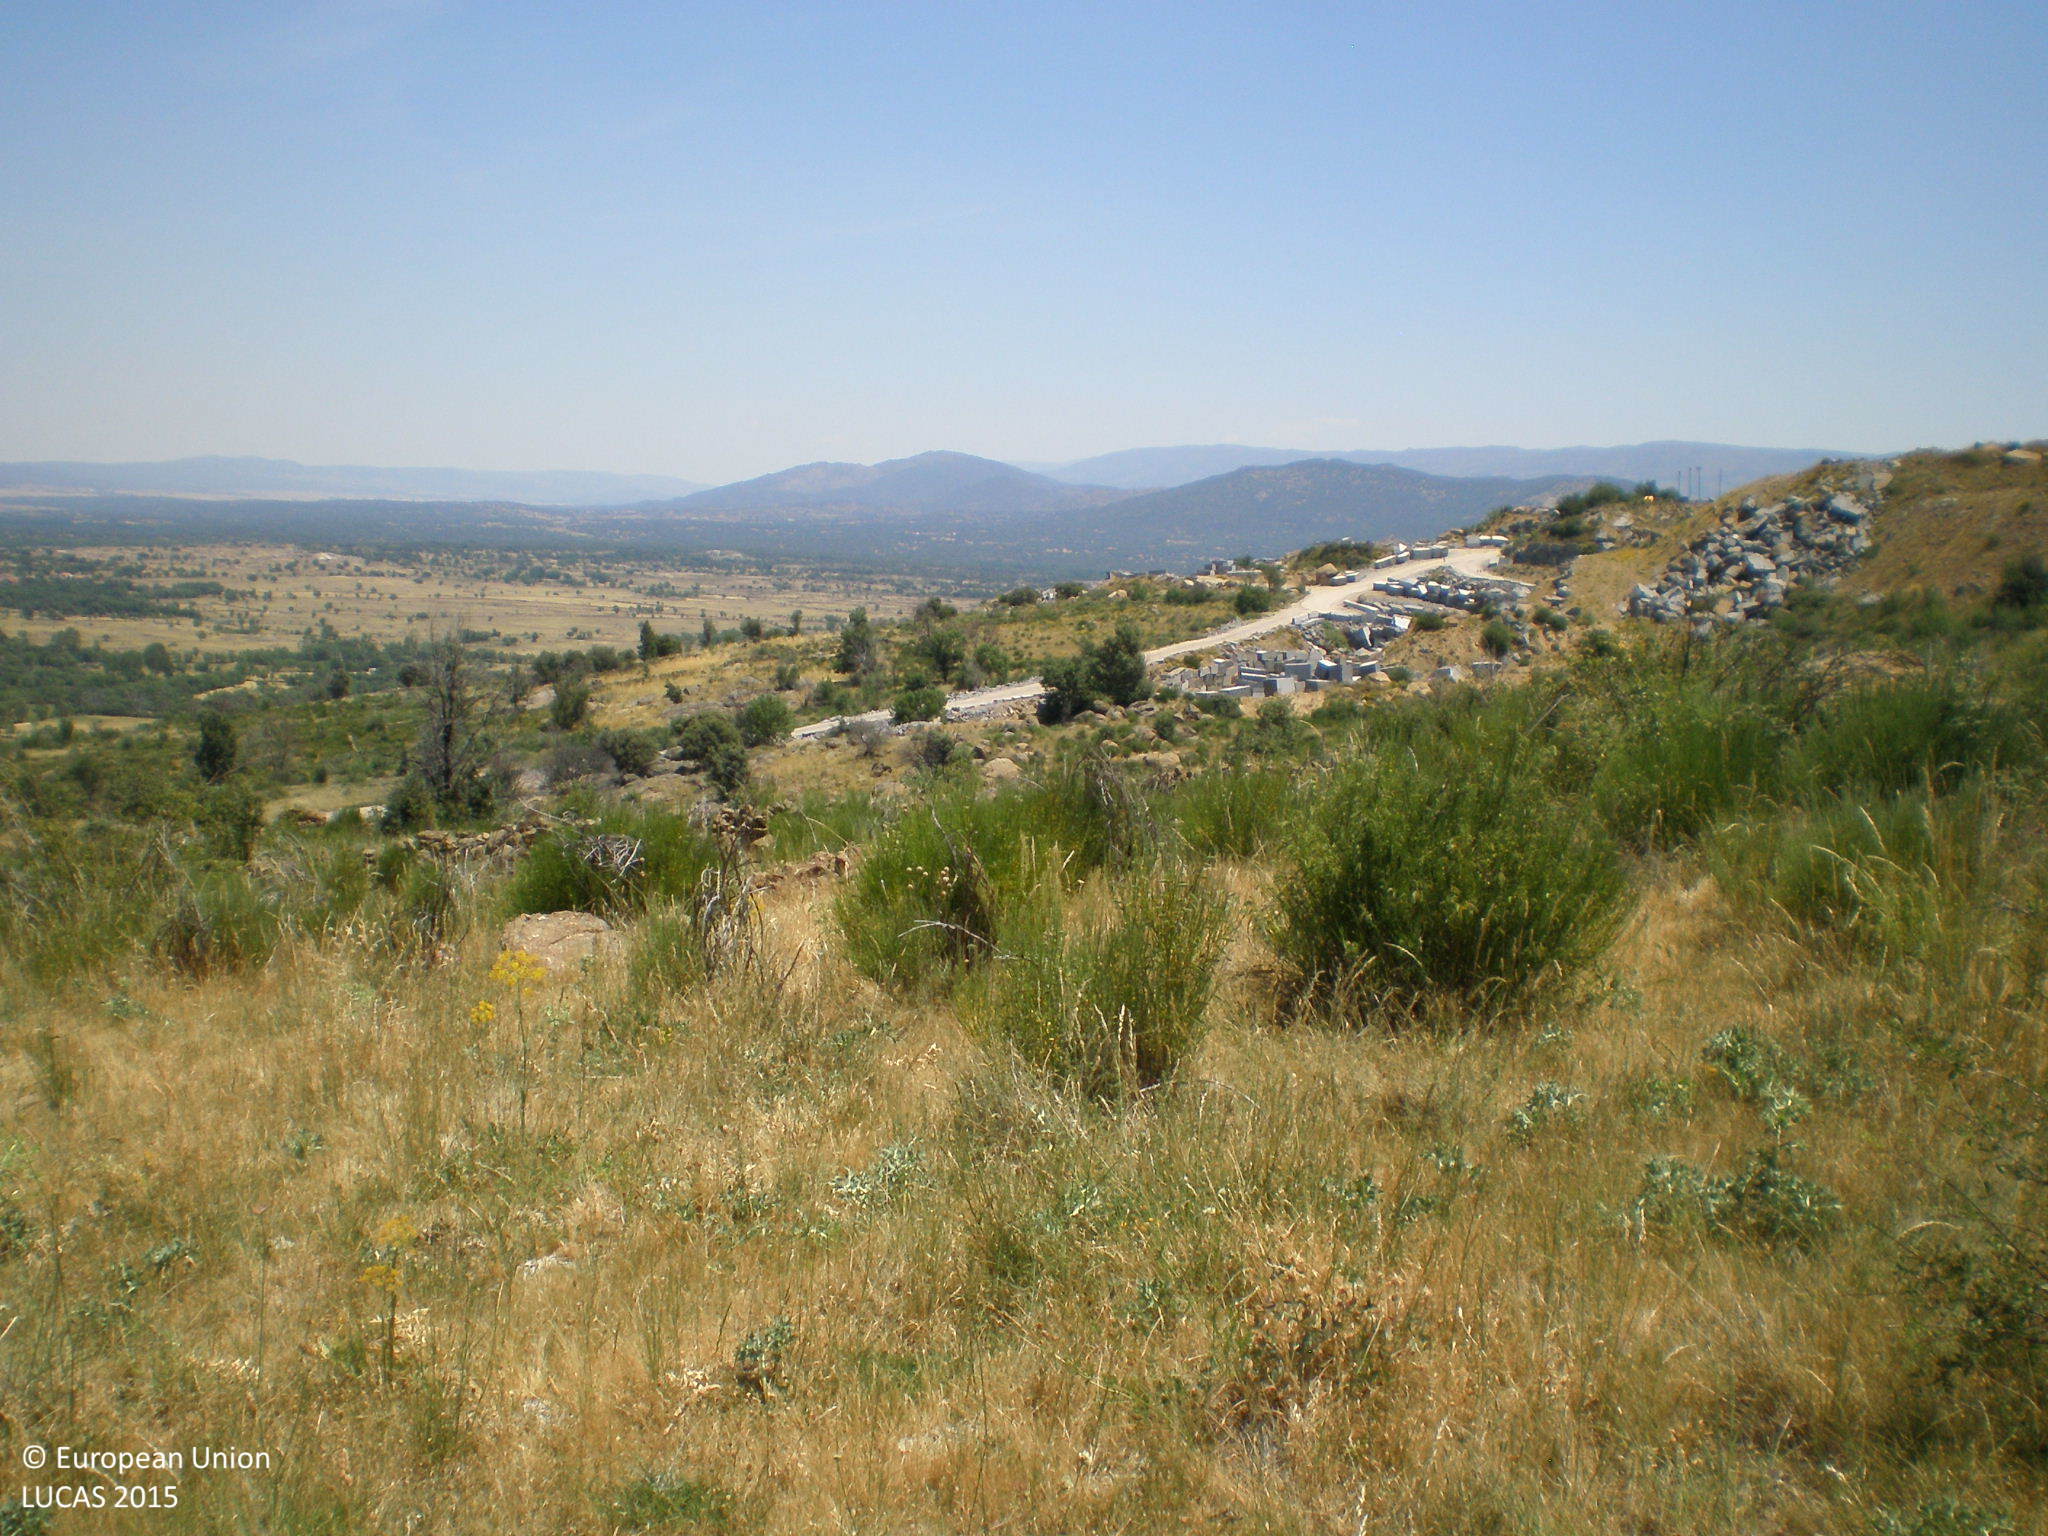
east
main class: Shrubland
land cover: Shrubland without tree cover
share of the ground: 50 - 75 %
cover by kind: shrubs 70 %, herbaceous plants 30 %
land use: Semi-natural and natural areas not in use
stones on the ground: < 10 %
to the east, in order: Shrubland without tree cover; Dry stone walls; Shrubland without tree cover; Dry stone walls; Shrubland without tree cover; Dry stone walls; Shrubland without tree cover
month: June
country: ES
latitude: 40.3924
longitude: -5.5828
